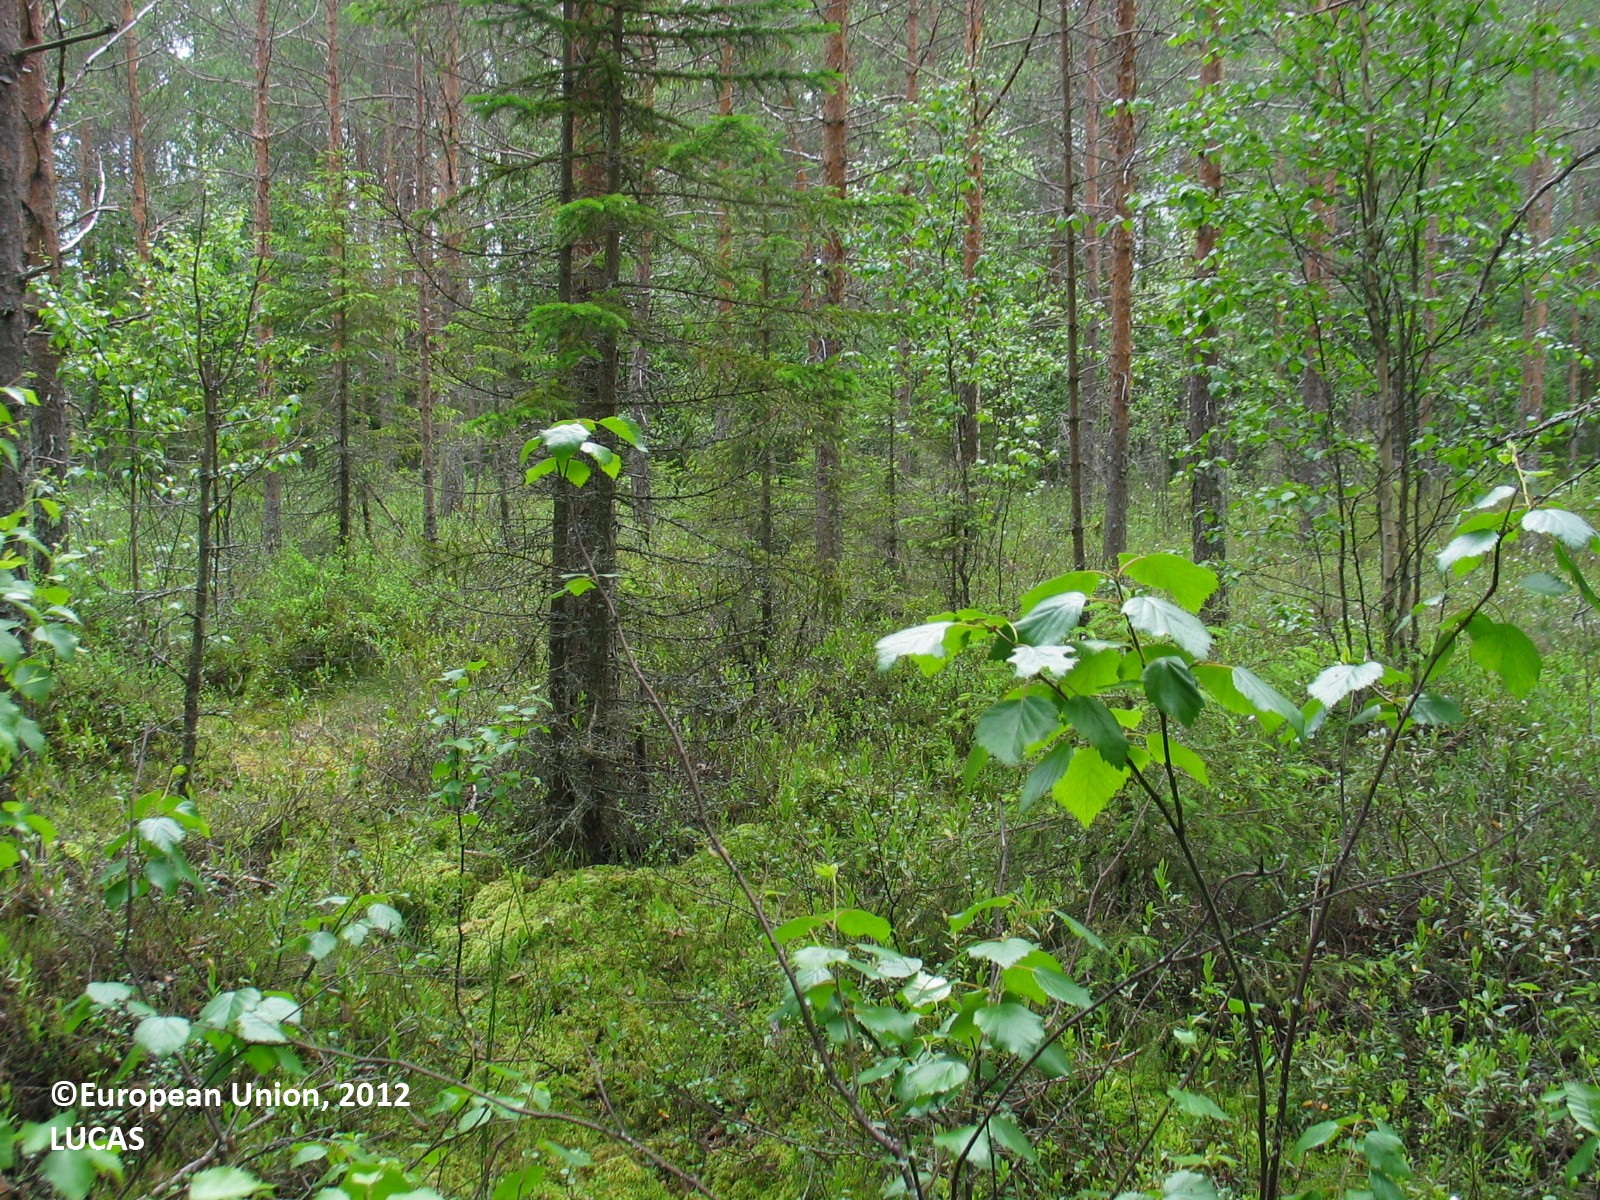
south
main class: Woodland
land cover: Other mixed woodland
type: boreal forest
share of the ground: 50 - 75 %
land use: Forestry
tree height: > 5 m
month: June
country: FI
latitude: 64.8257
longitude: 26.4809
